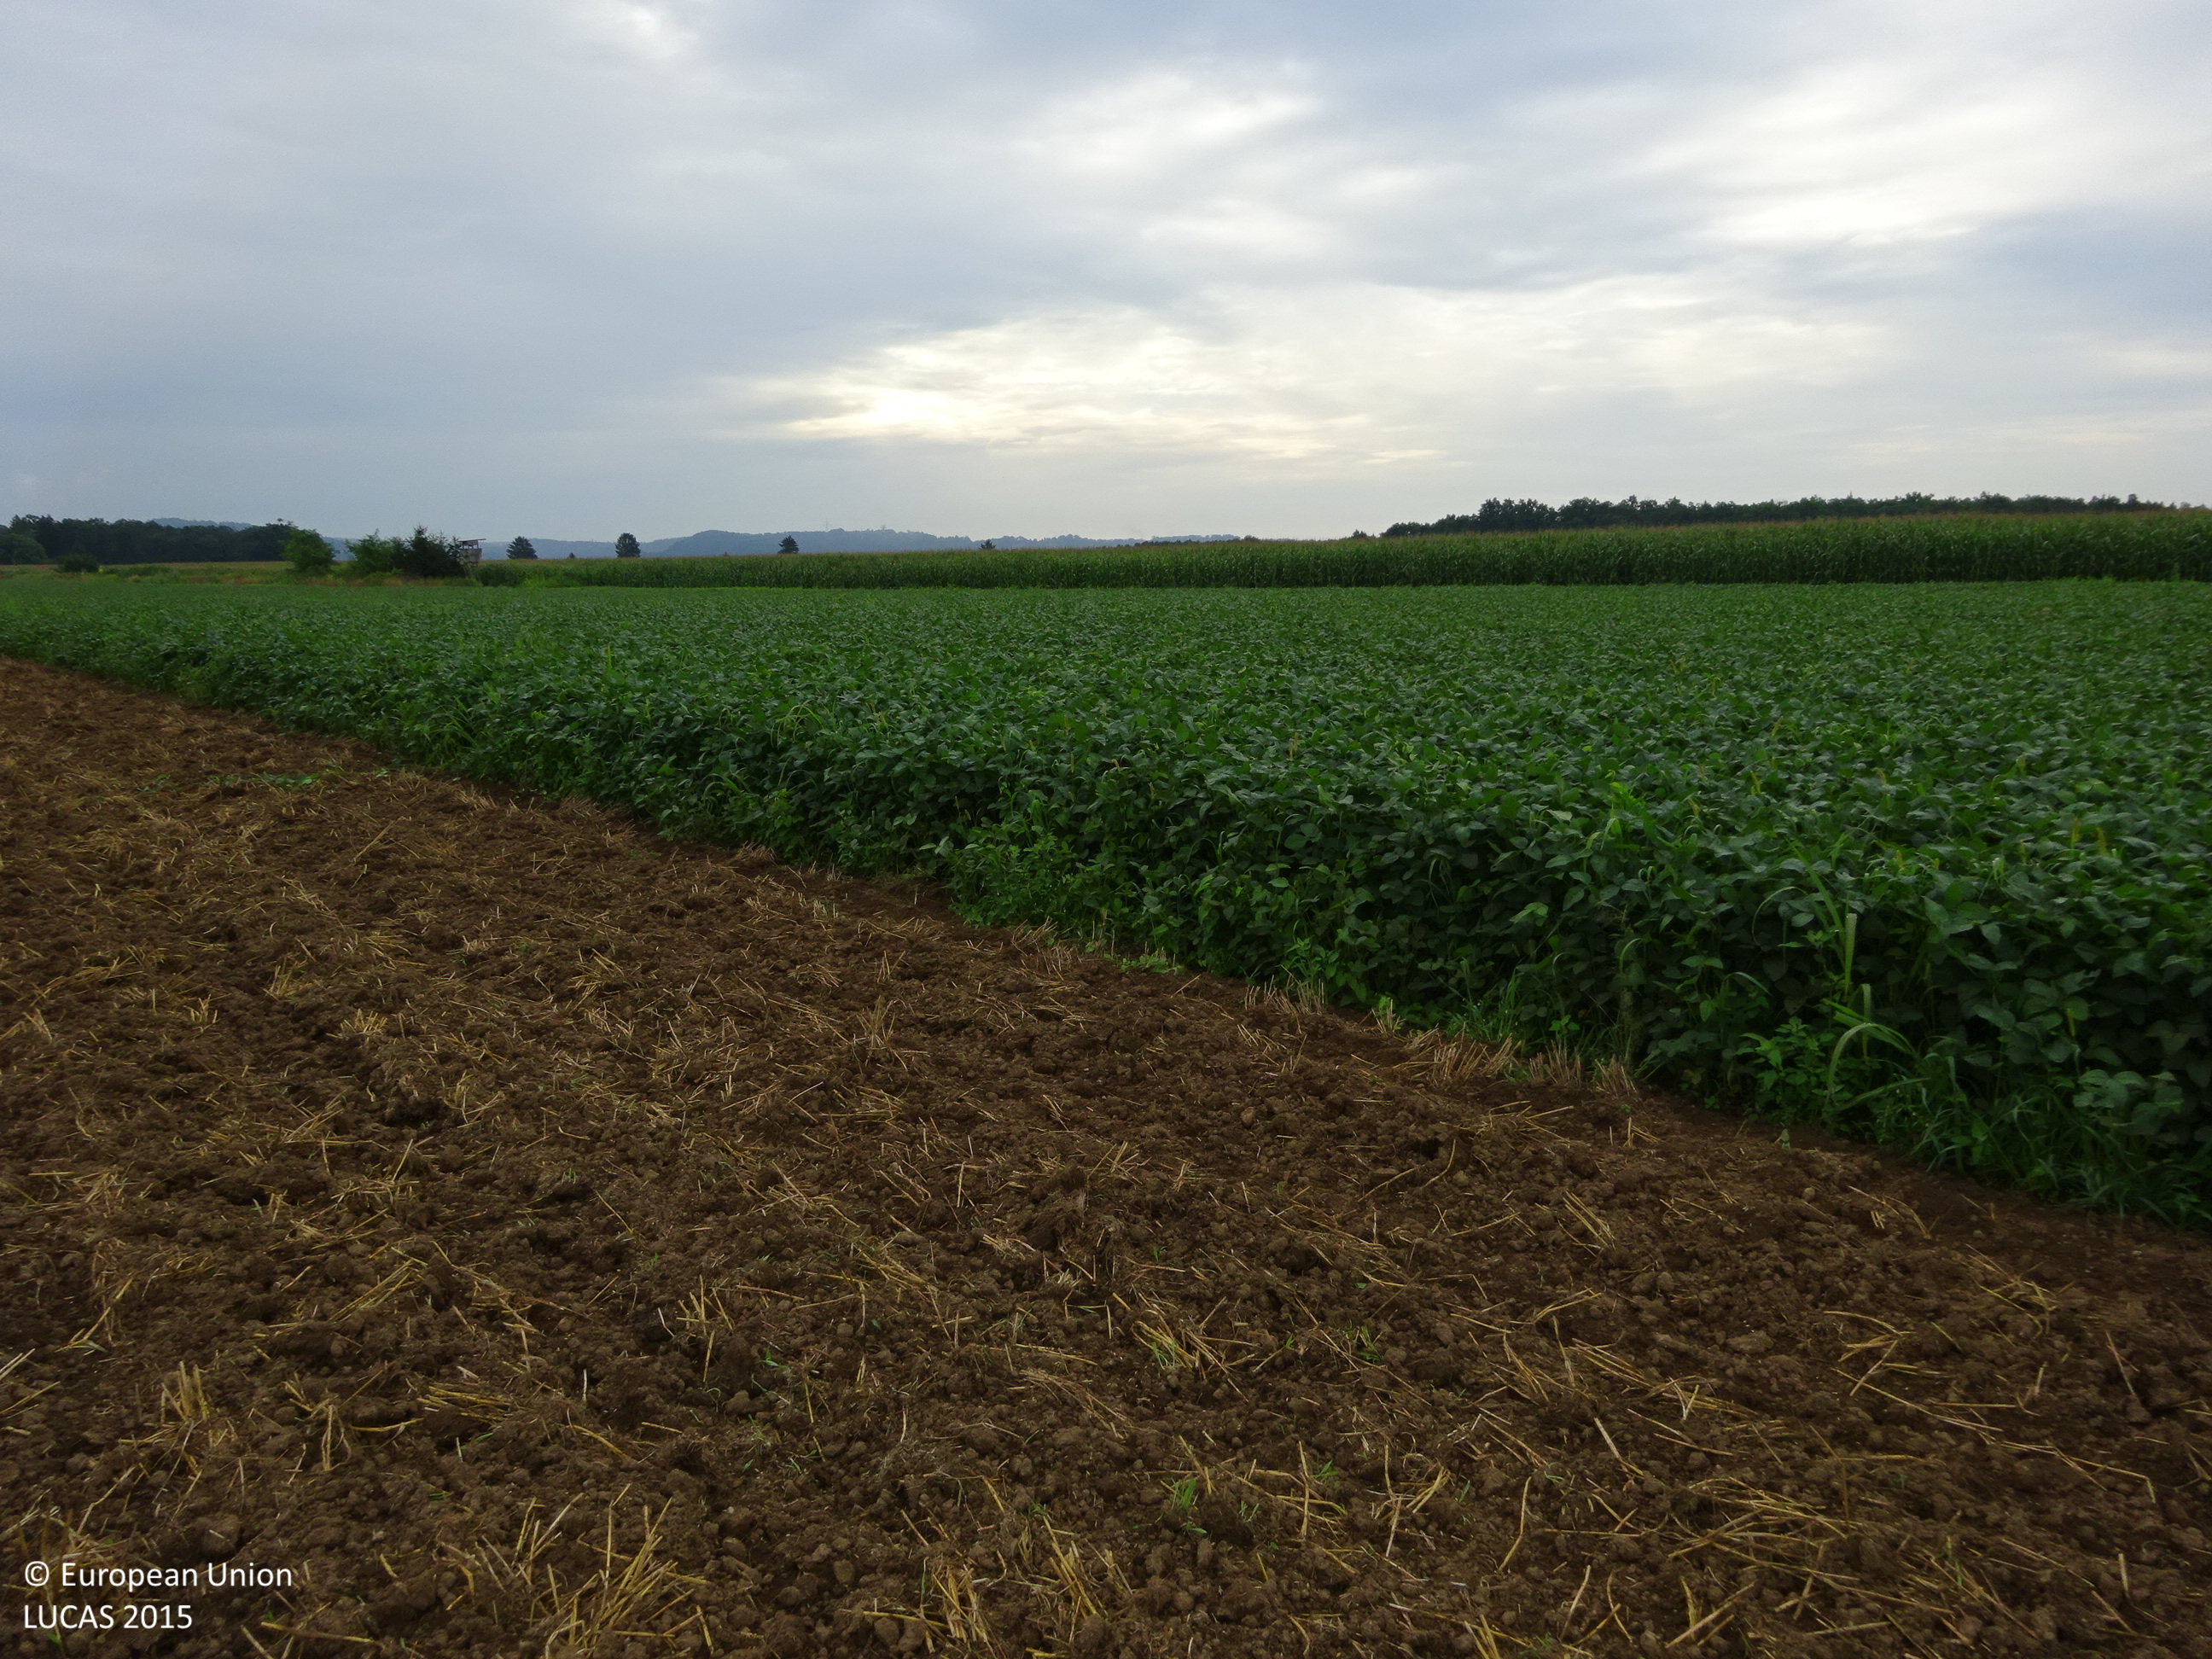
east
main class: Cropland
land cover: Barley
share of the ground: > 75 %
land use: Agriculture (excluding fallow land and kitchen gardens)
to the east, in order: Barley; Soya; Maize
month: July
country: AT
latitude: 46.9521
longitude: 15.4525
